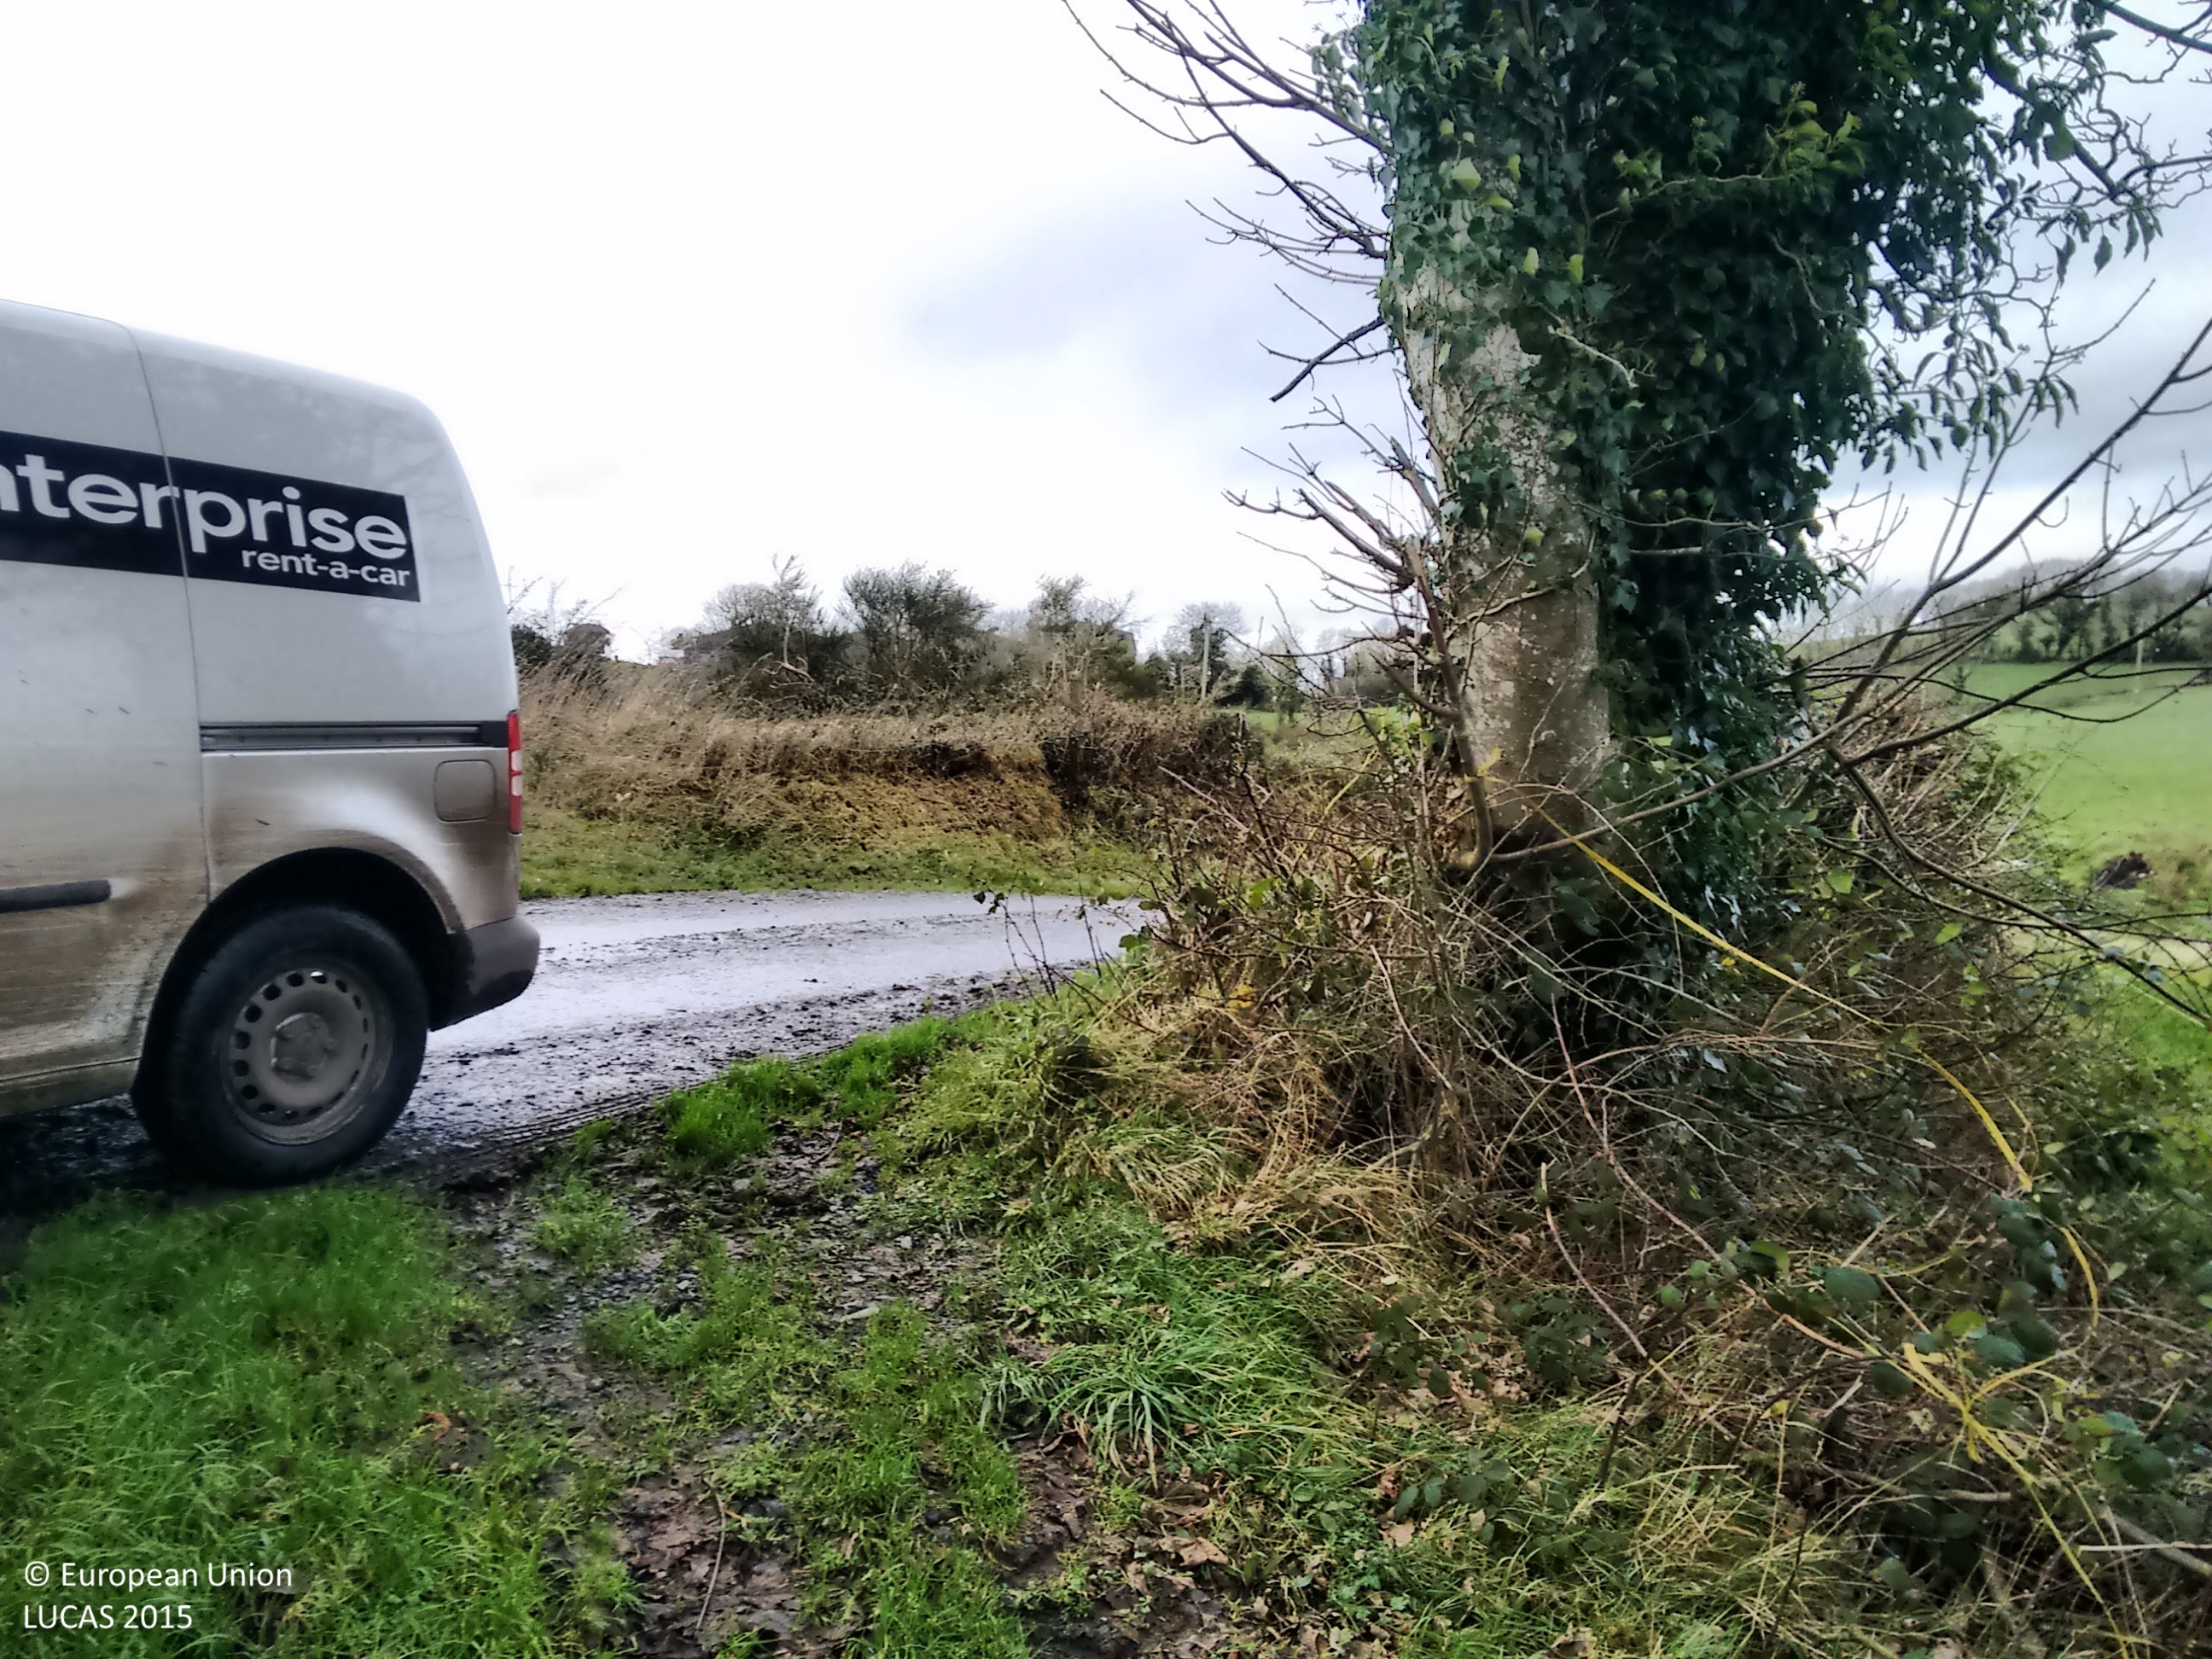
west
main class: Grassland
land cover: Grassland without tree/shrub cover
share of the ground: > 75 %
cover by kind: herbaceous plants 100 %
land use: Agriculture (excluding fallow land and kitchen gardens)
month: December
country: IE
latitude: 54.0825
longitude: -7.0010
